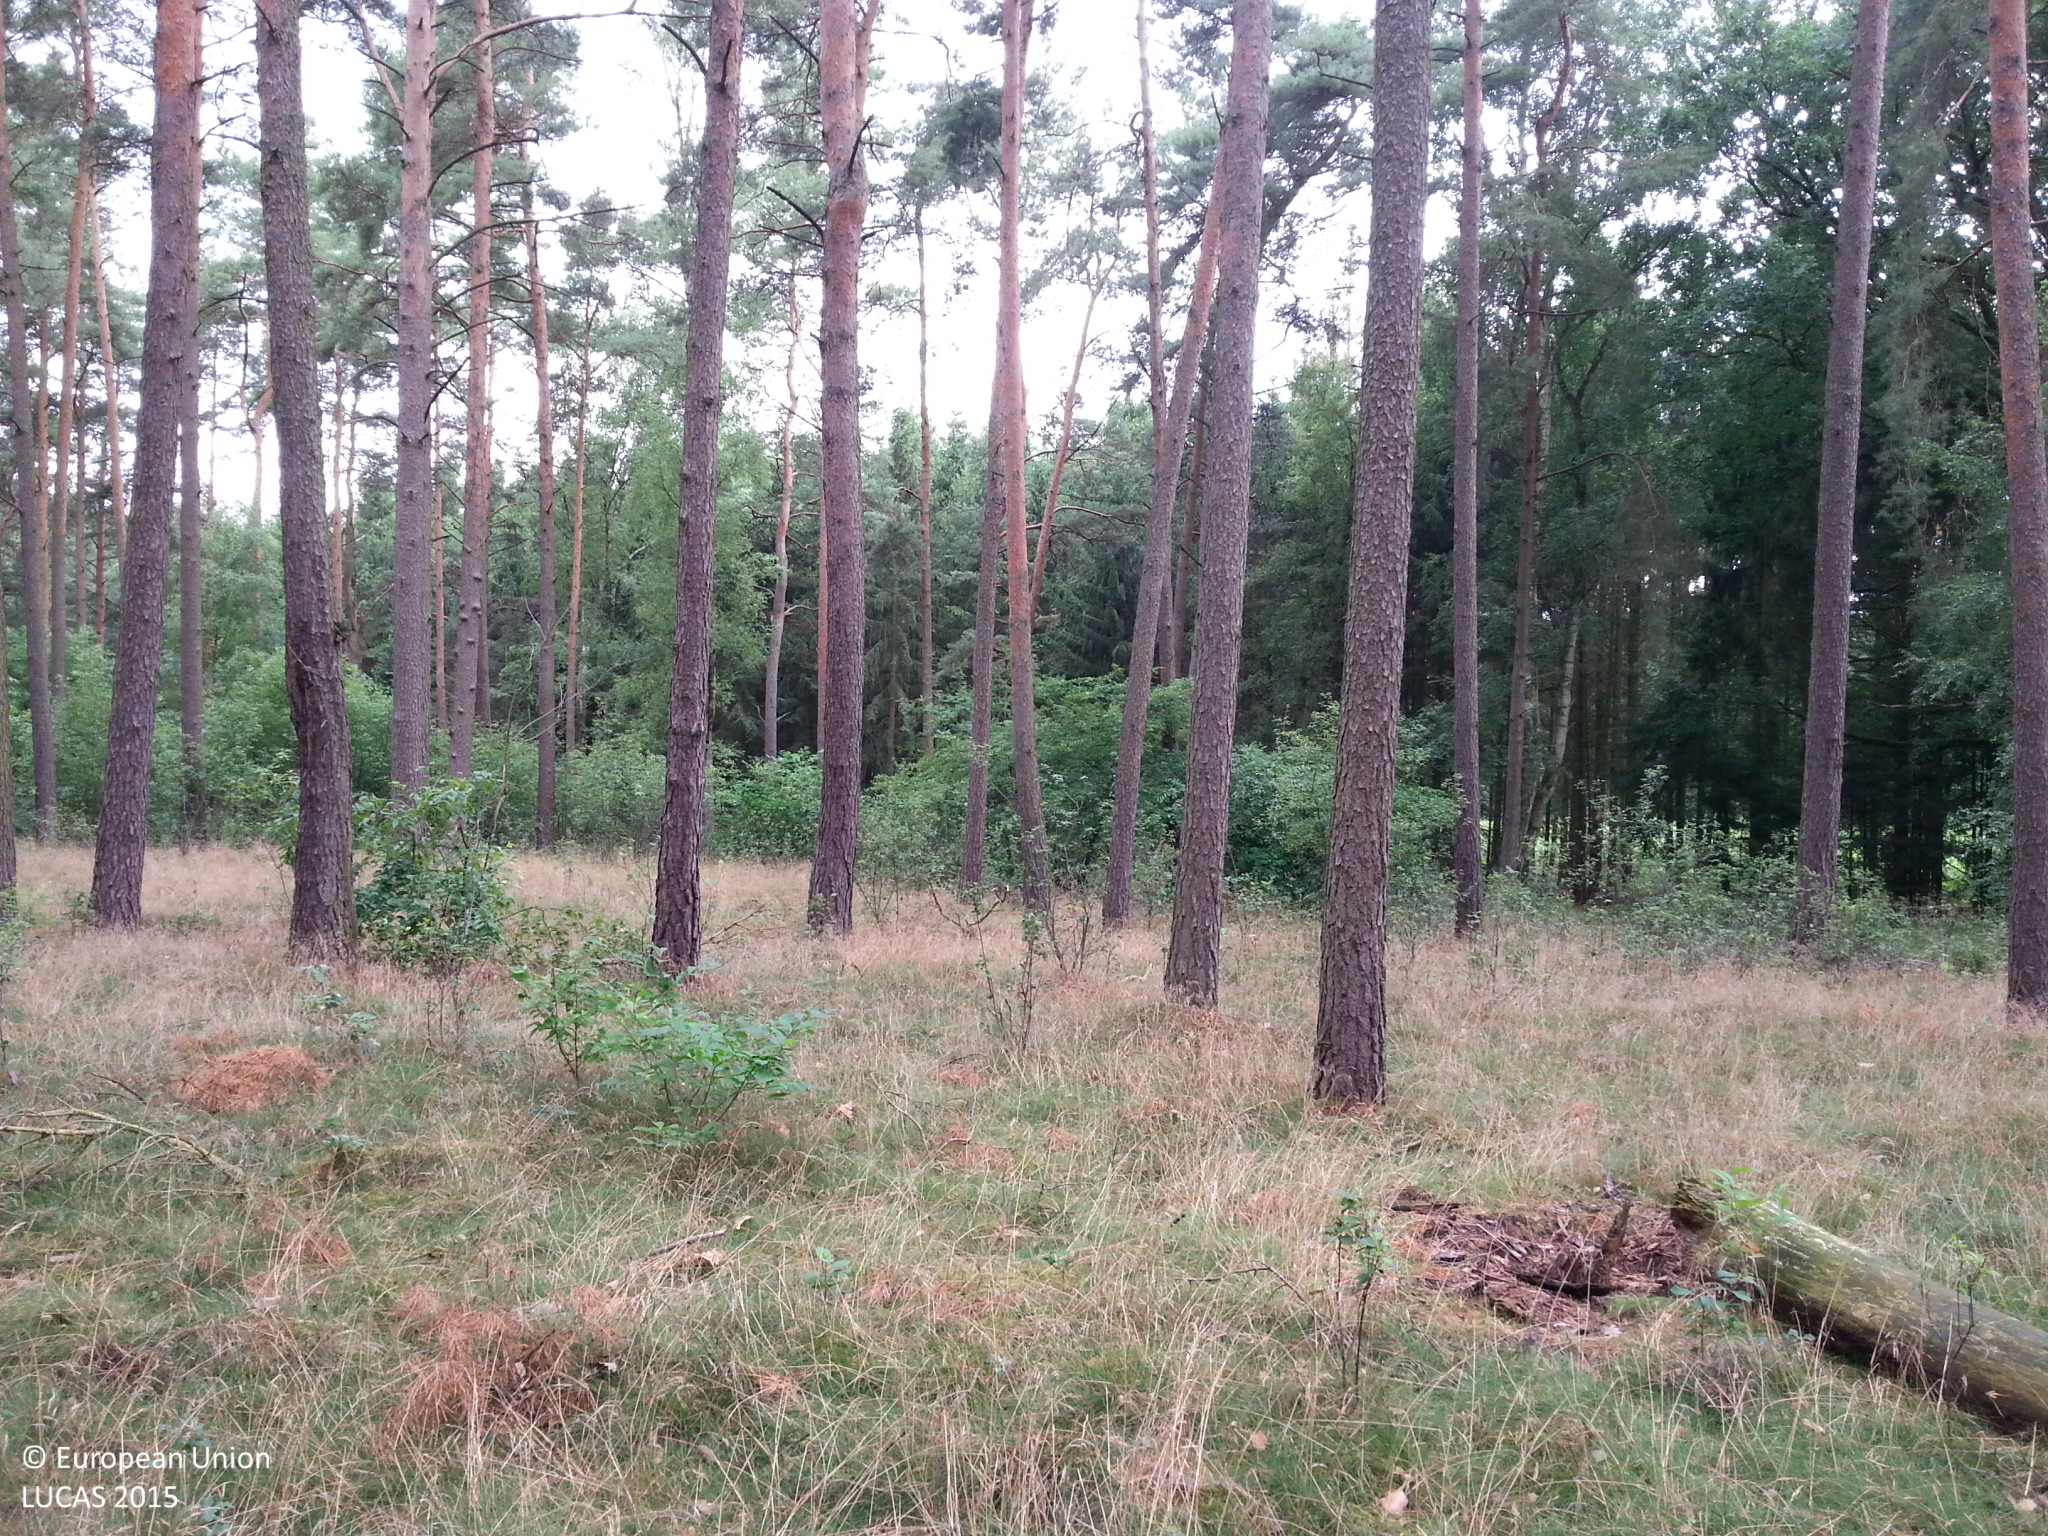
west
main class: Woodland
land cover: Pine dominated coniferous woodland
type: boreal forest
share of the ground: 50 - 75 %
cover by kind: coniferous forest trees 50 %, herbaceous plants 30 %, shrubs 15 %, lichens and mosses 5 %
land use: Forestry
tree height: > 5 m
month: July
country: DE
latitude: 53.0377
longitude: 12.3409
